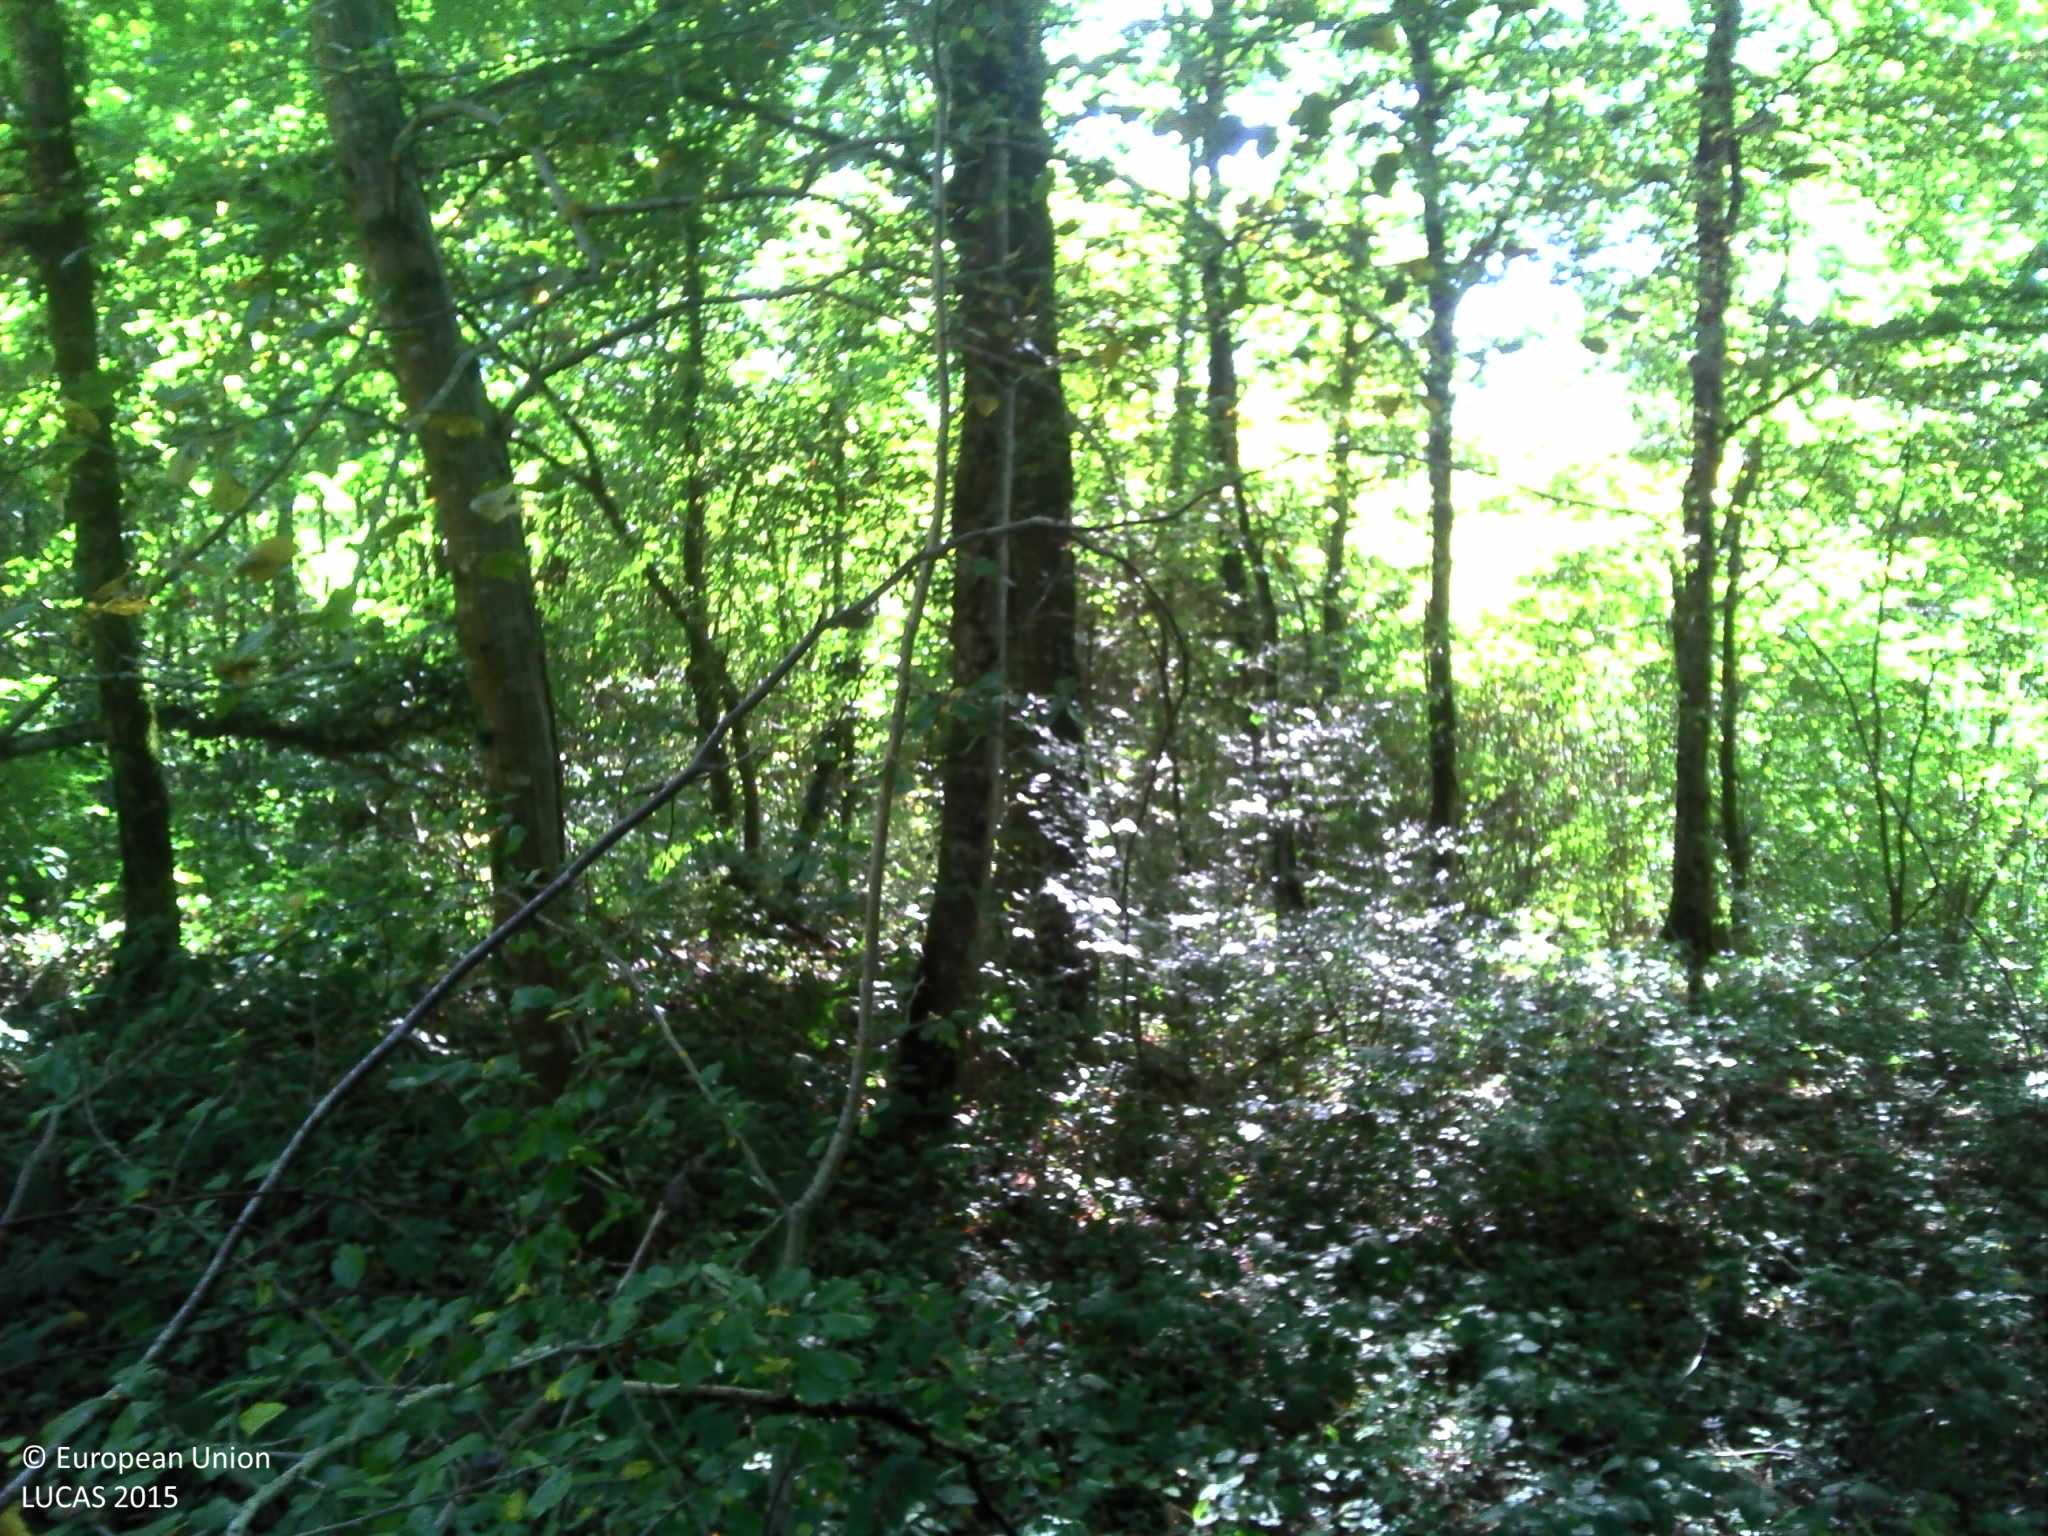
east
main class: Woodland
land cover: Broadleaved woodland
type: beech forest
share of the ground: > 75 %
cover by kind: broadleaved forest trees 80 %, herbaceous plants 15 %, shrubs 5 %
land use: Forestry
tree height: > 5 m
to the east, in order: Broadleaved woodland; Grass margins; Ditches and canals; Grass margins; Paved roads, cycling and walking lanes; Grass margins; Fences; Grassland without tree/shrub cover; Broadleaved woodland; Grassland without tree/shrub cover; Broadleaved woodland
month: September
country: FR
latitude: 47.3690
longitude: 6.3071
